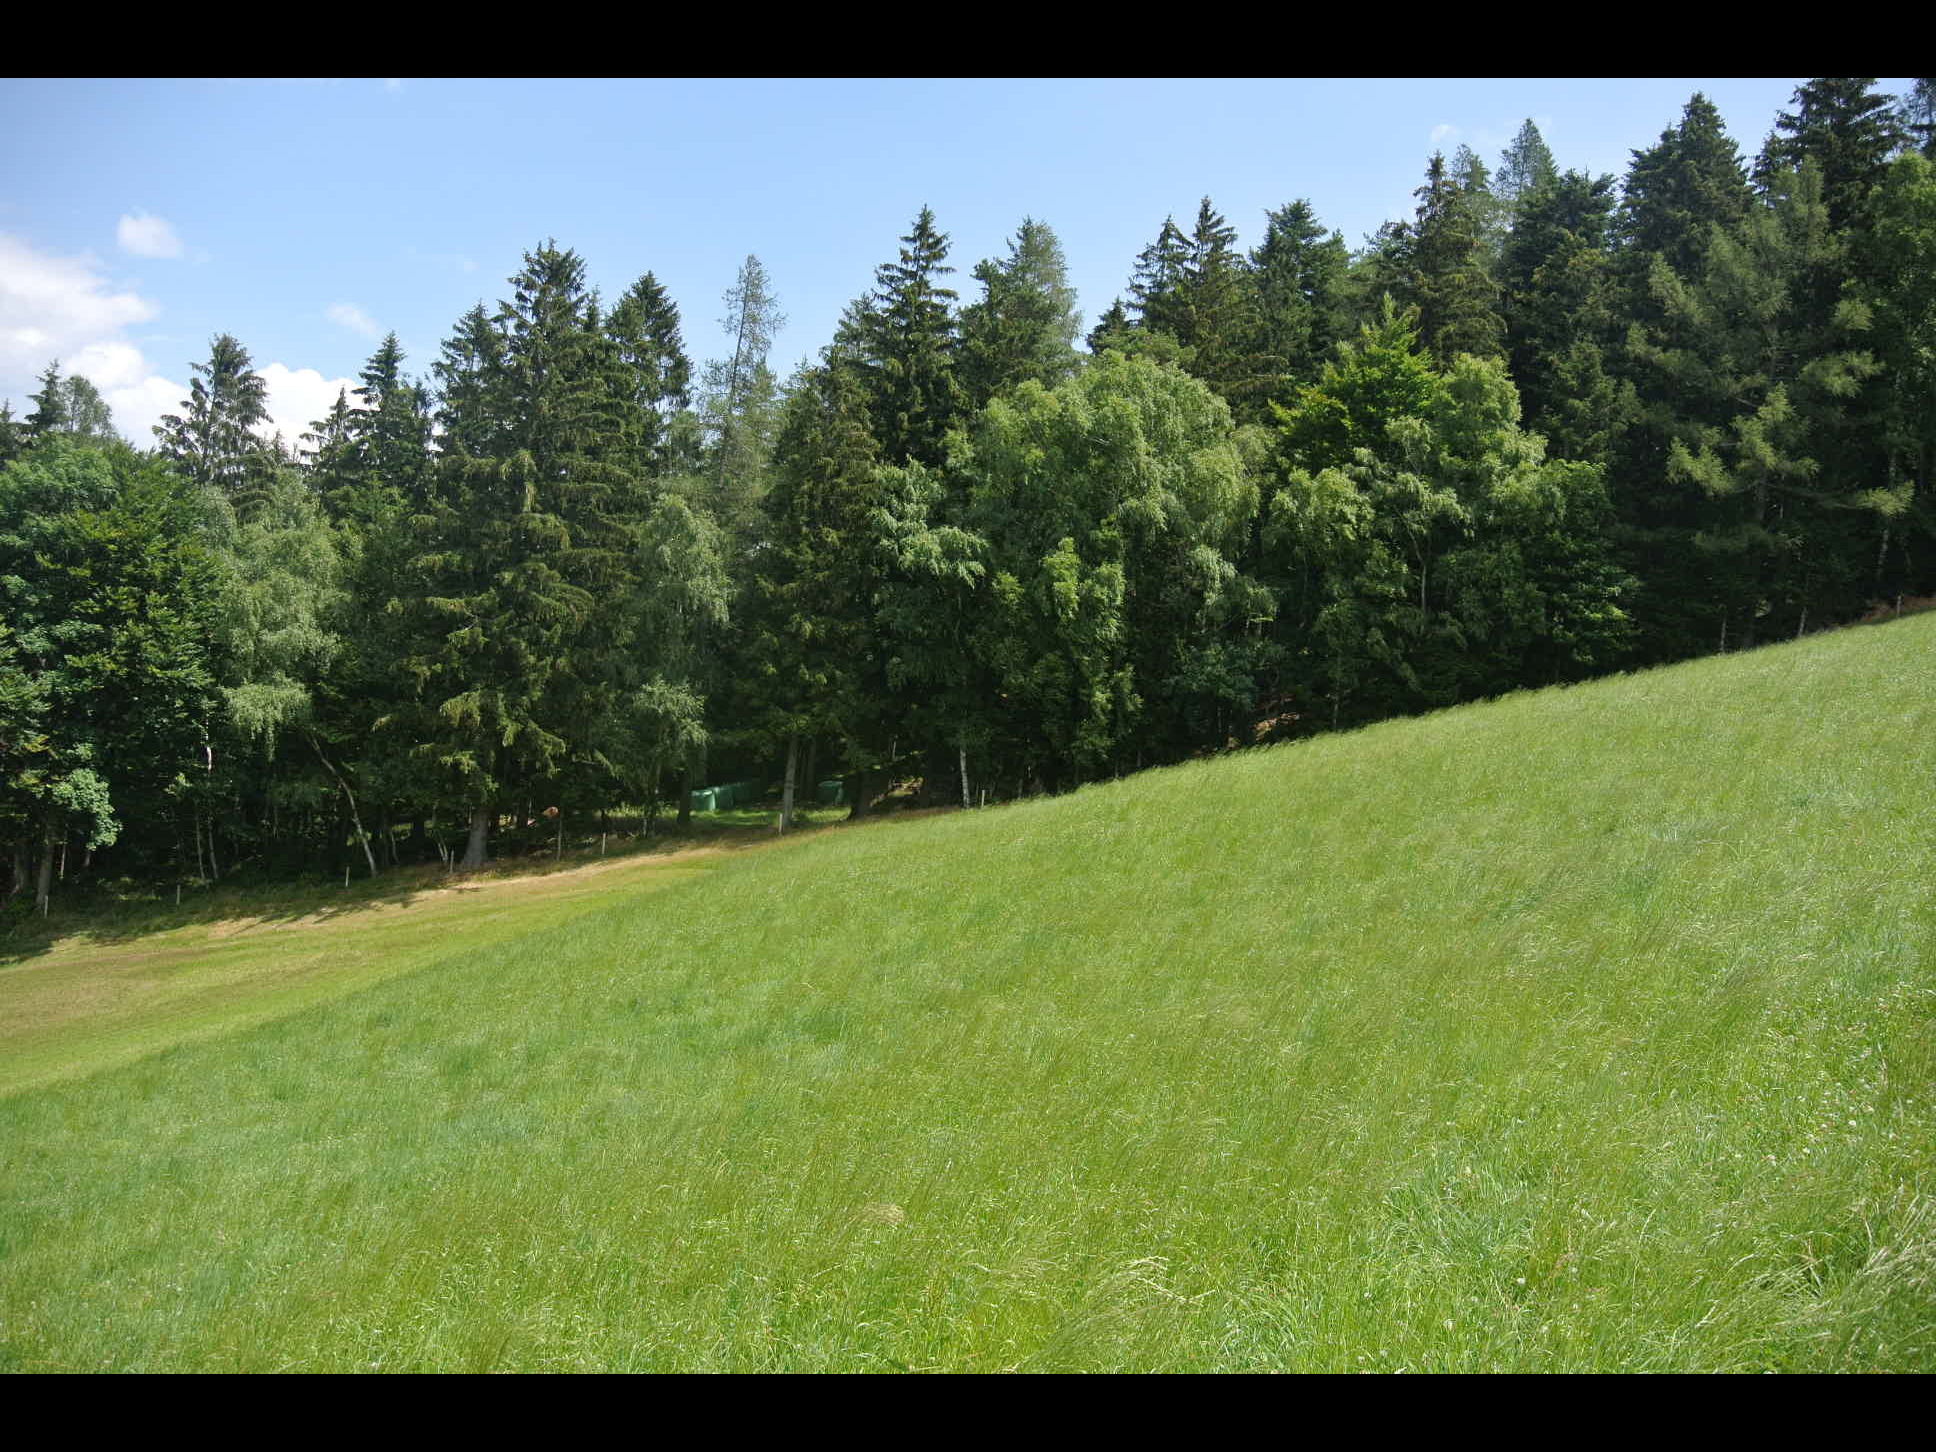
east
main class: Grassland
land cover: Grassland without tree/shrub cover
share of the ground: > 75 %
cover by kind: herbaceous plants 100 %
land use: Agriculture (excluding fallow land and kitchen gardens)
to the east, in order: Grassland without tree/shrub cover; Spruce dominated mixed woodland; Tracks; Spruce dominated coniferous woodland; Tracks; Spruce dominated coniferous woodland
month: July
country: AT
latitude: 47.5880
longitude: 16.0529
